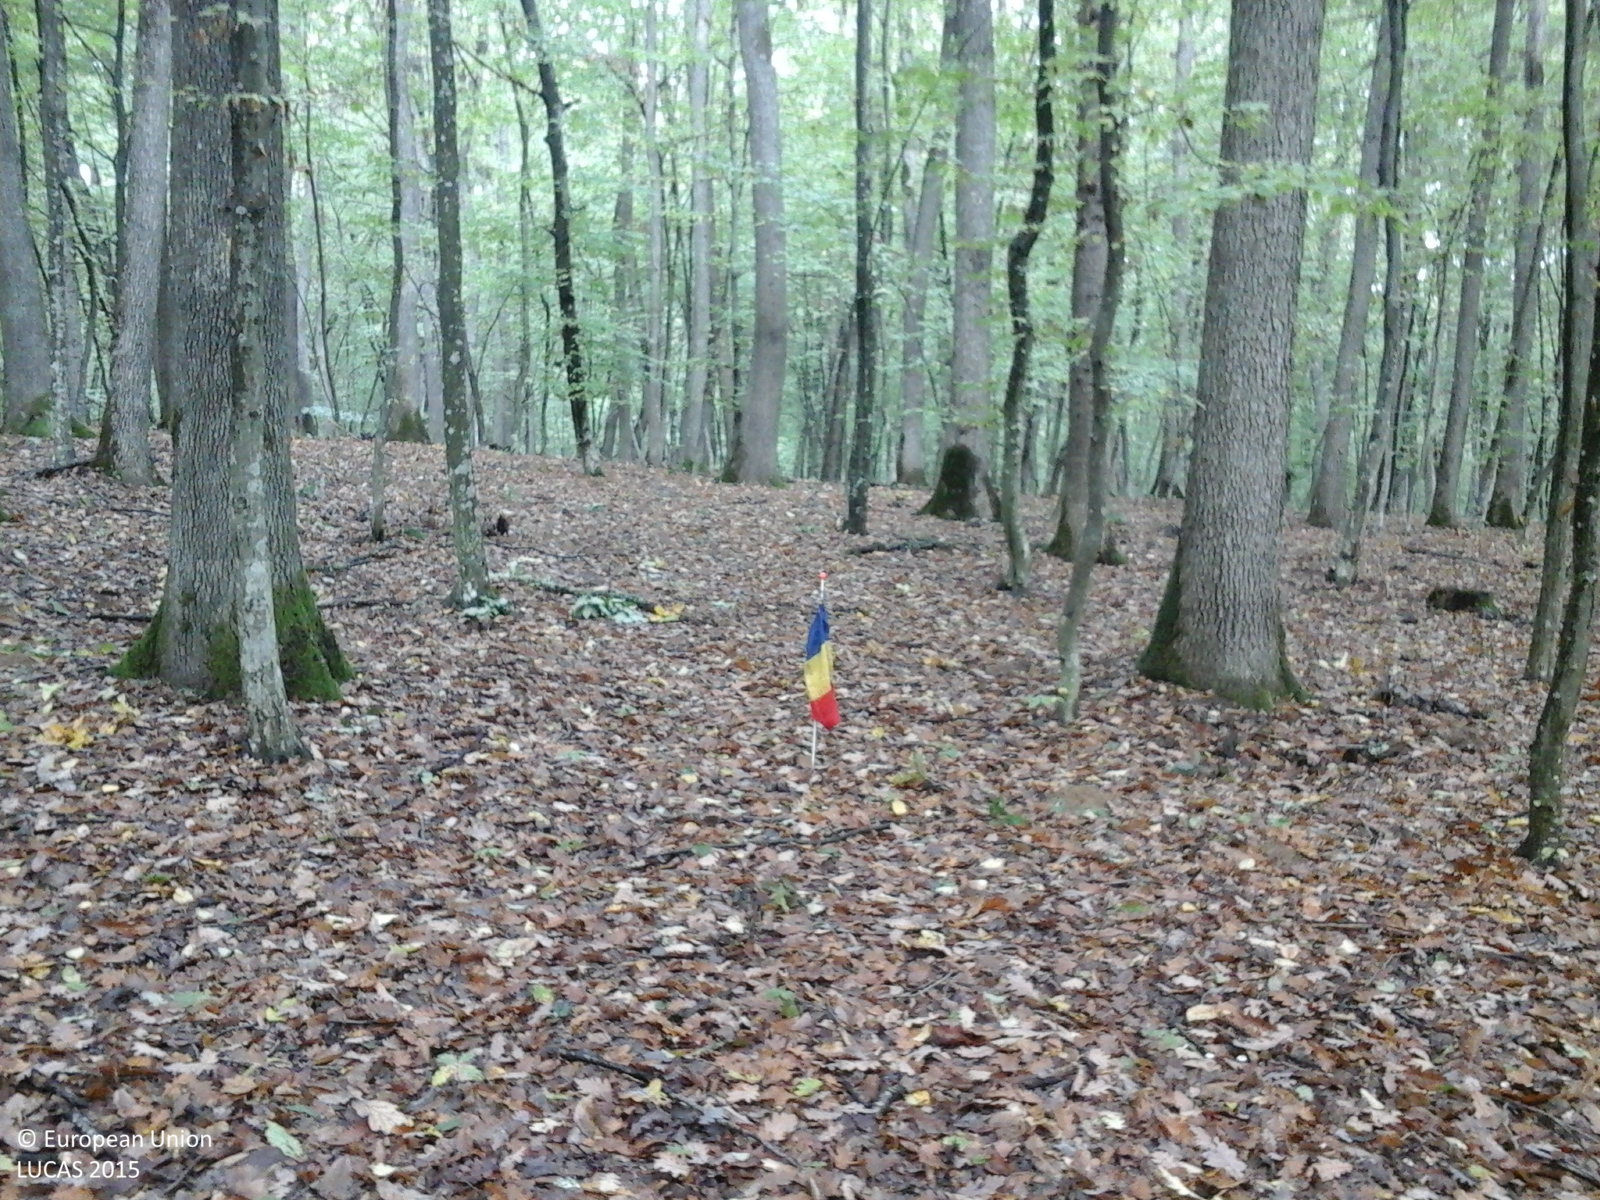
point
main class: Woodland
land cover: Broadleaved woodland
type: beech forest
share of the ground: > 75 %
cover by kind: broadleaved forest trees 100 %
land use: Forestry
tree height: > 5 m
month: October
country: RO
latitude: 45.8798
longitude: 24.6843
